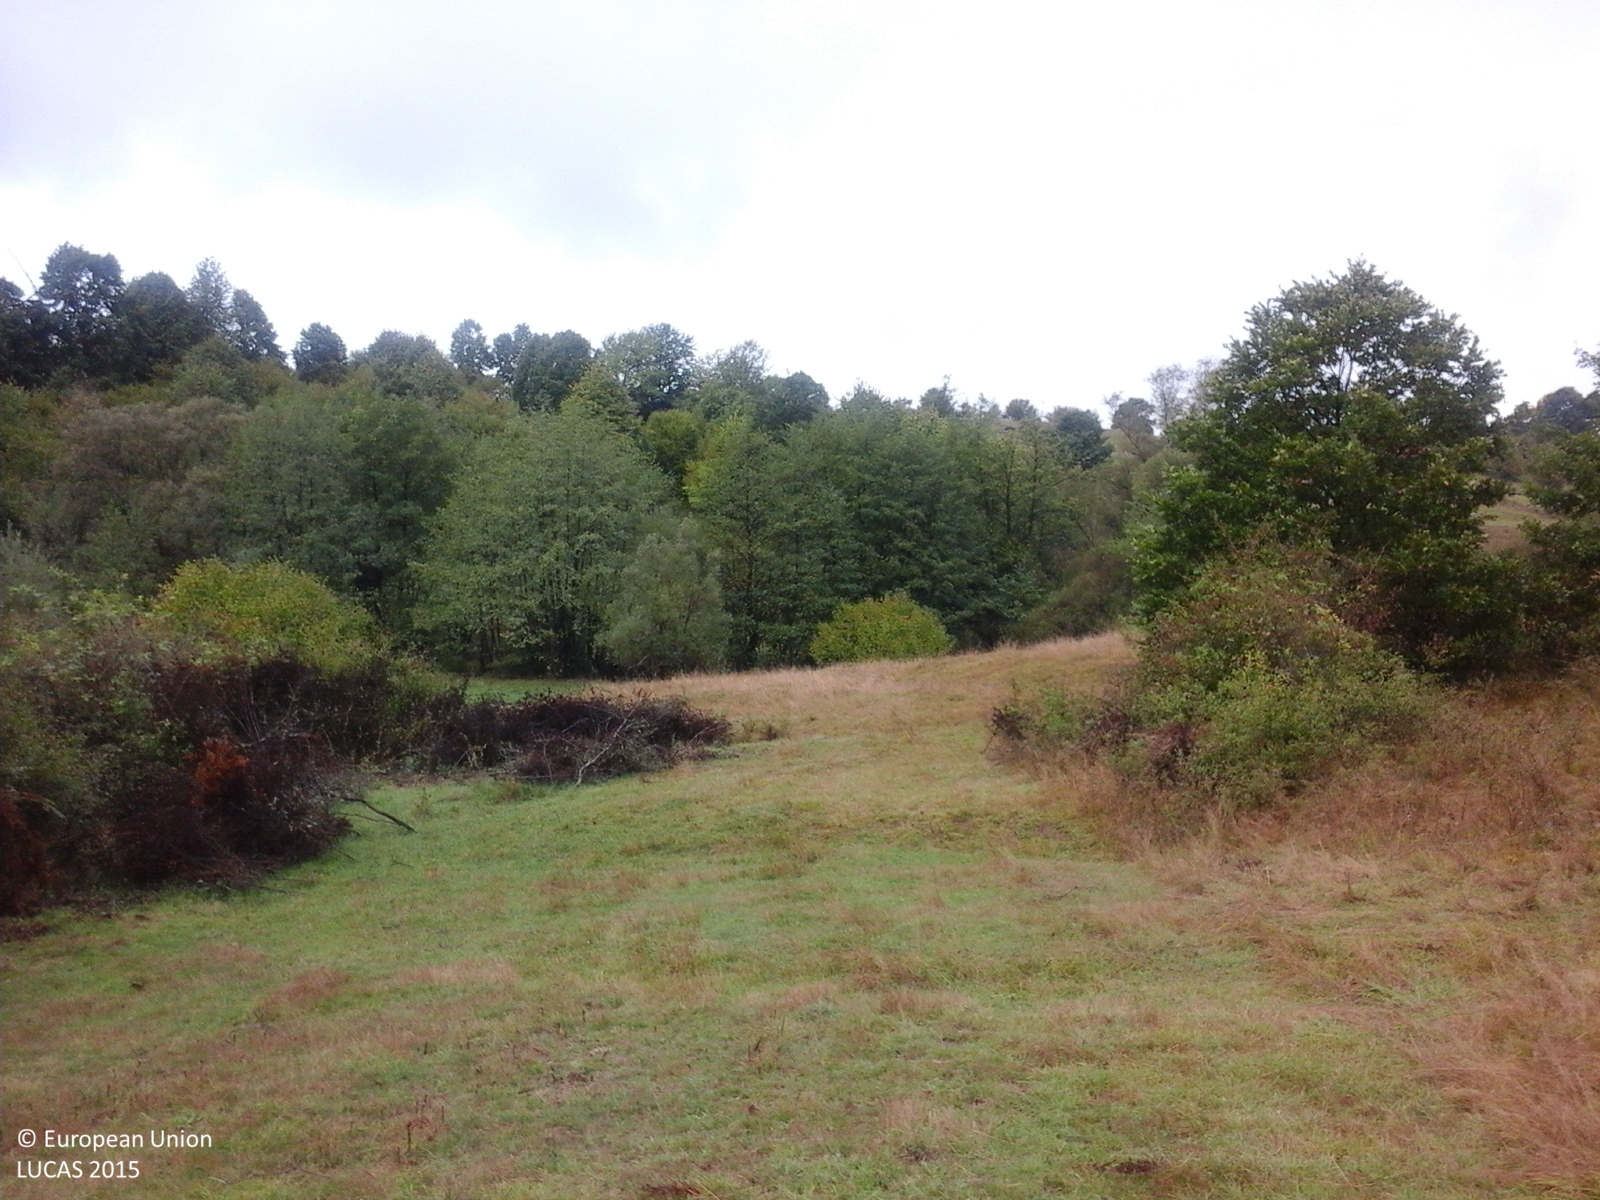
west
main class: Grassland
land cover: Grassland without tree/shrub cover
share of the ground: > 75 %
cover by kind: herbaceous plants 100 %
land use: Agriculture (excluding fallow land and kitchen gardens)
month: September
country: RO
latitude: 45.1516
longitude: 23.5806
